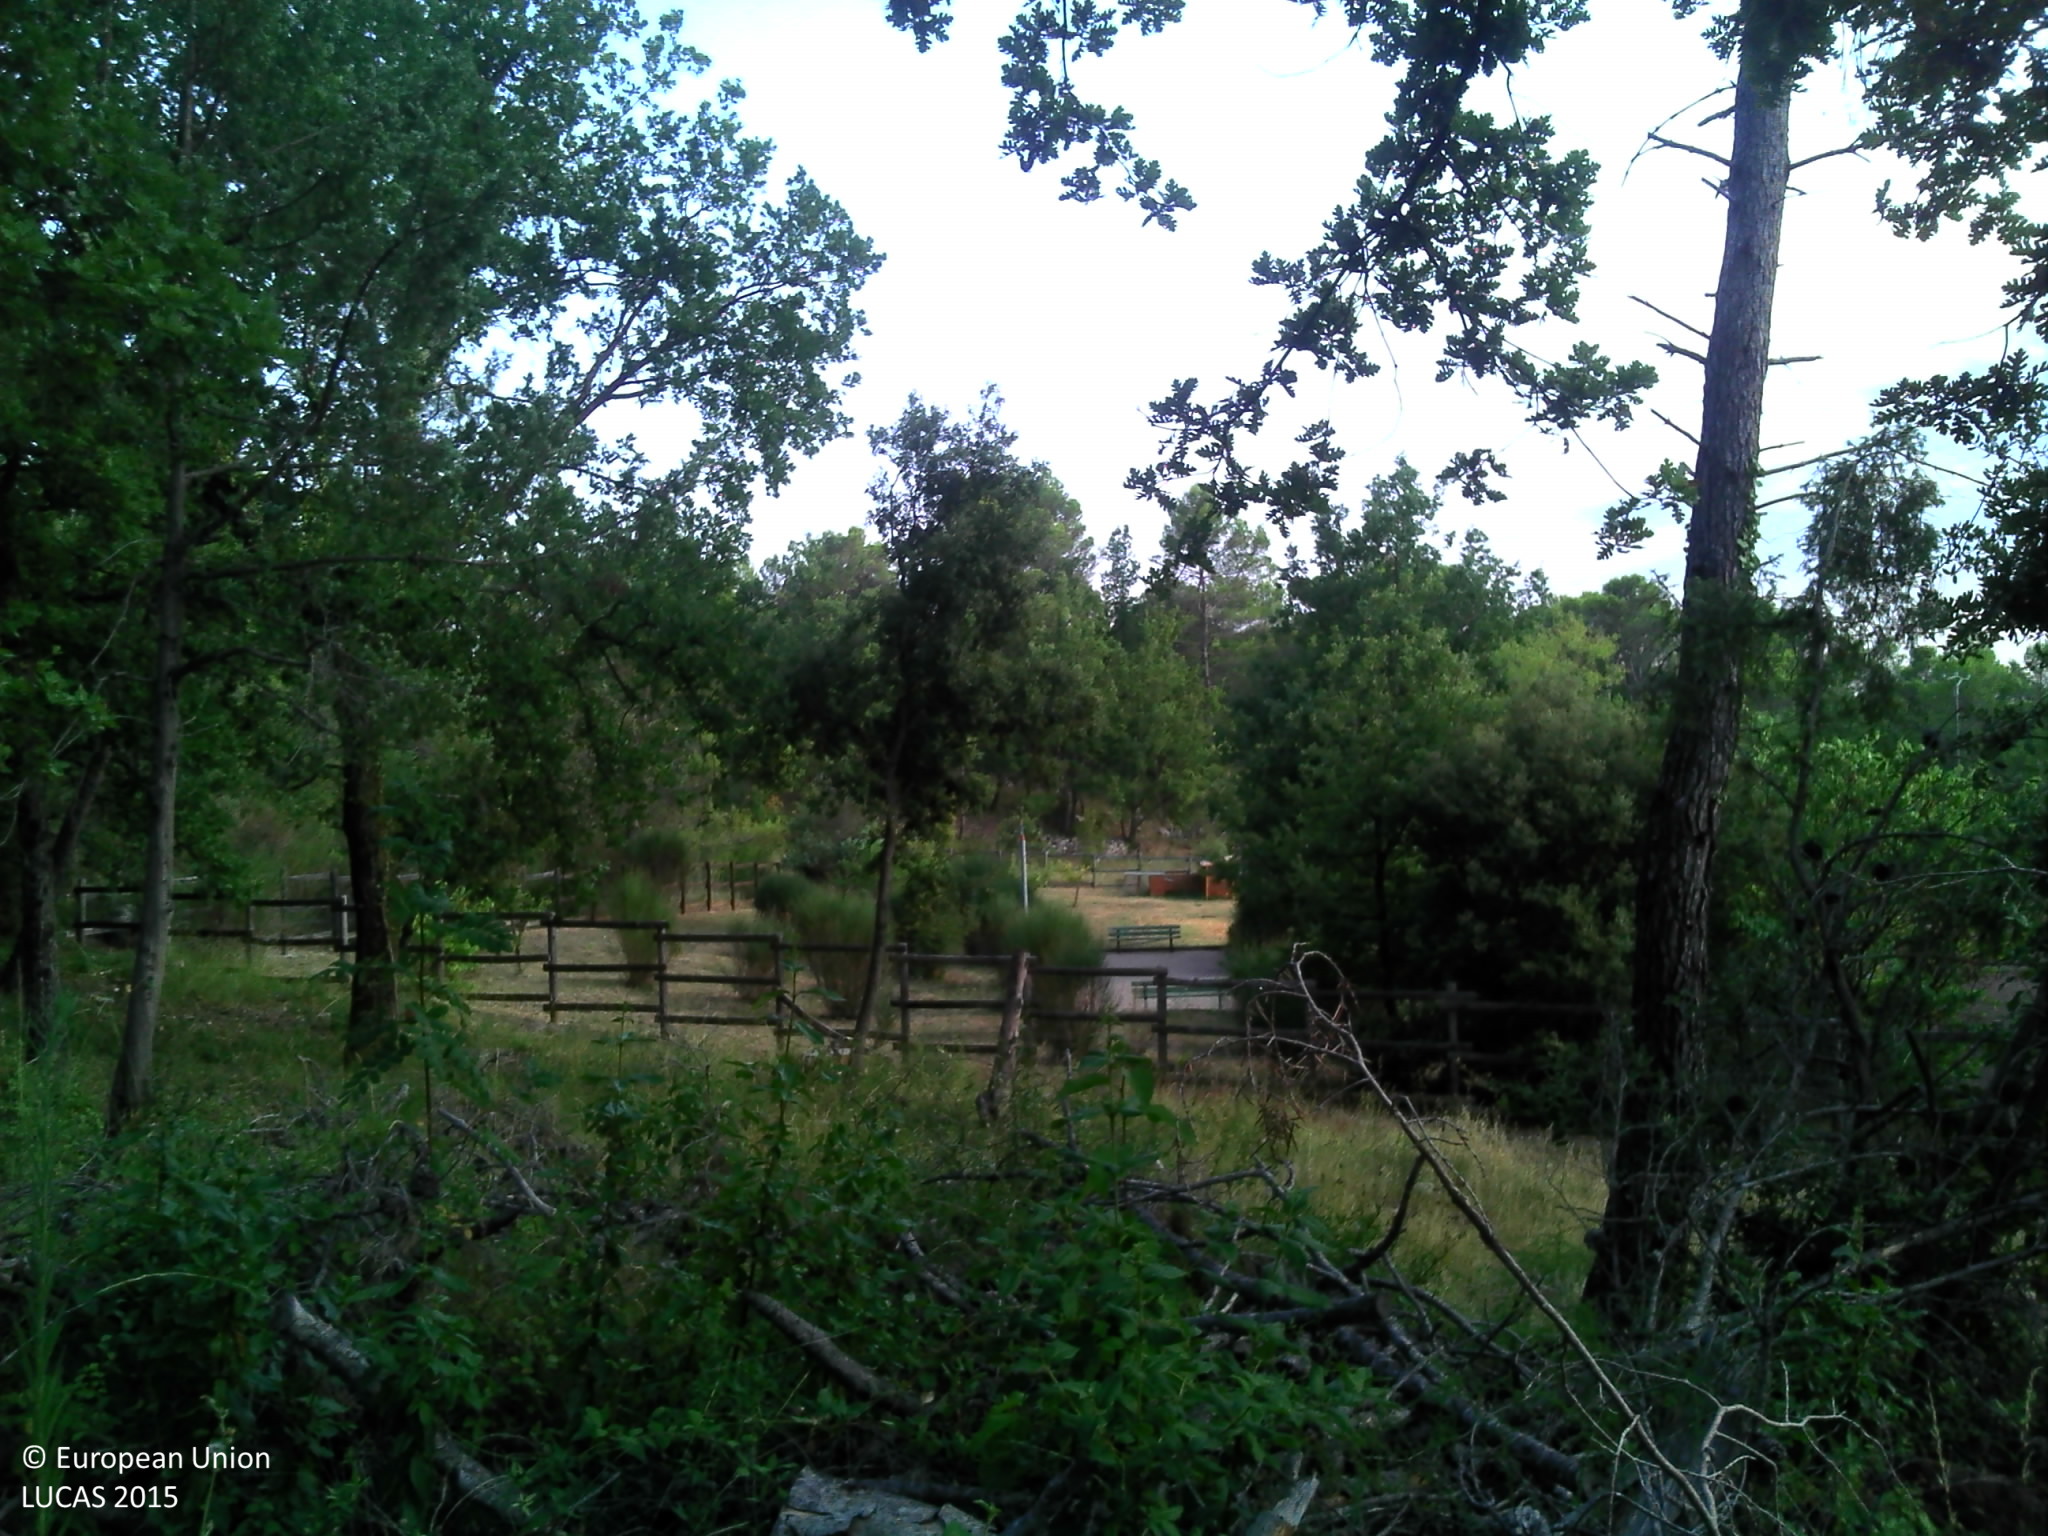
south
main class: Woodland
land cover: Pine dominated mixed woodland
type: coniferous forest of the mediterranean region
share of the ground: > 75 %
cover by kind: coniferous forest trees 50 %, broadleaved forest trees 25 %, shrubs 25 %
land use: Forestry
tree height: > 5 m
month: August
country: FR
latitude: 43.5256
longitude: 6.2846
